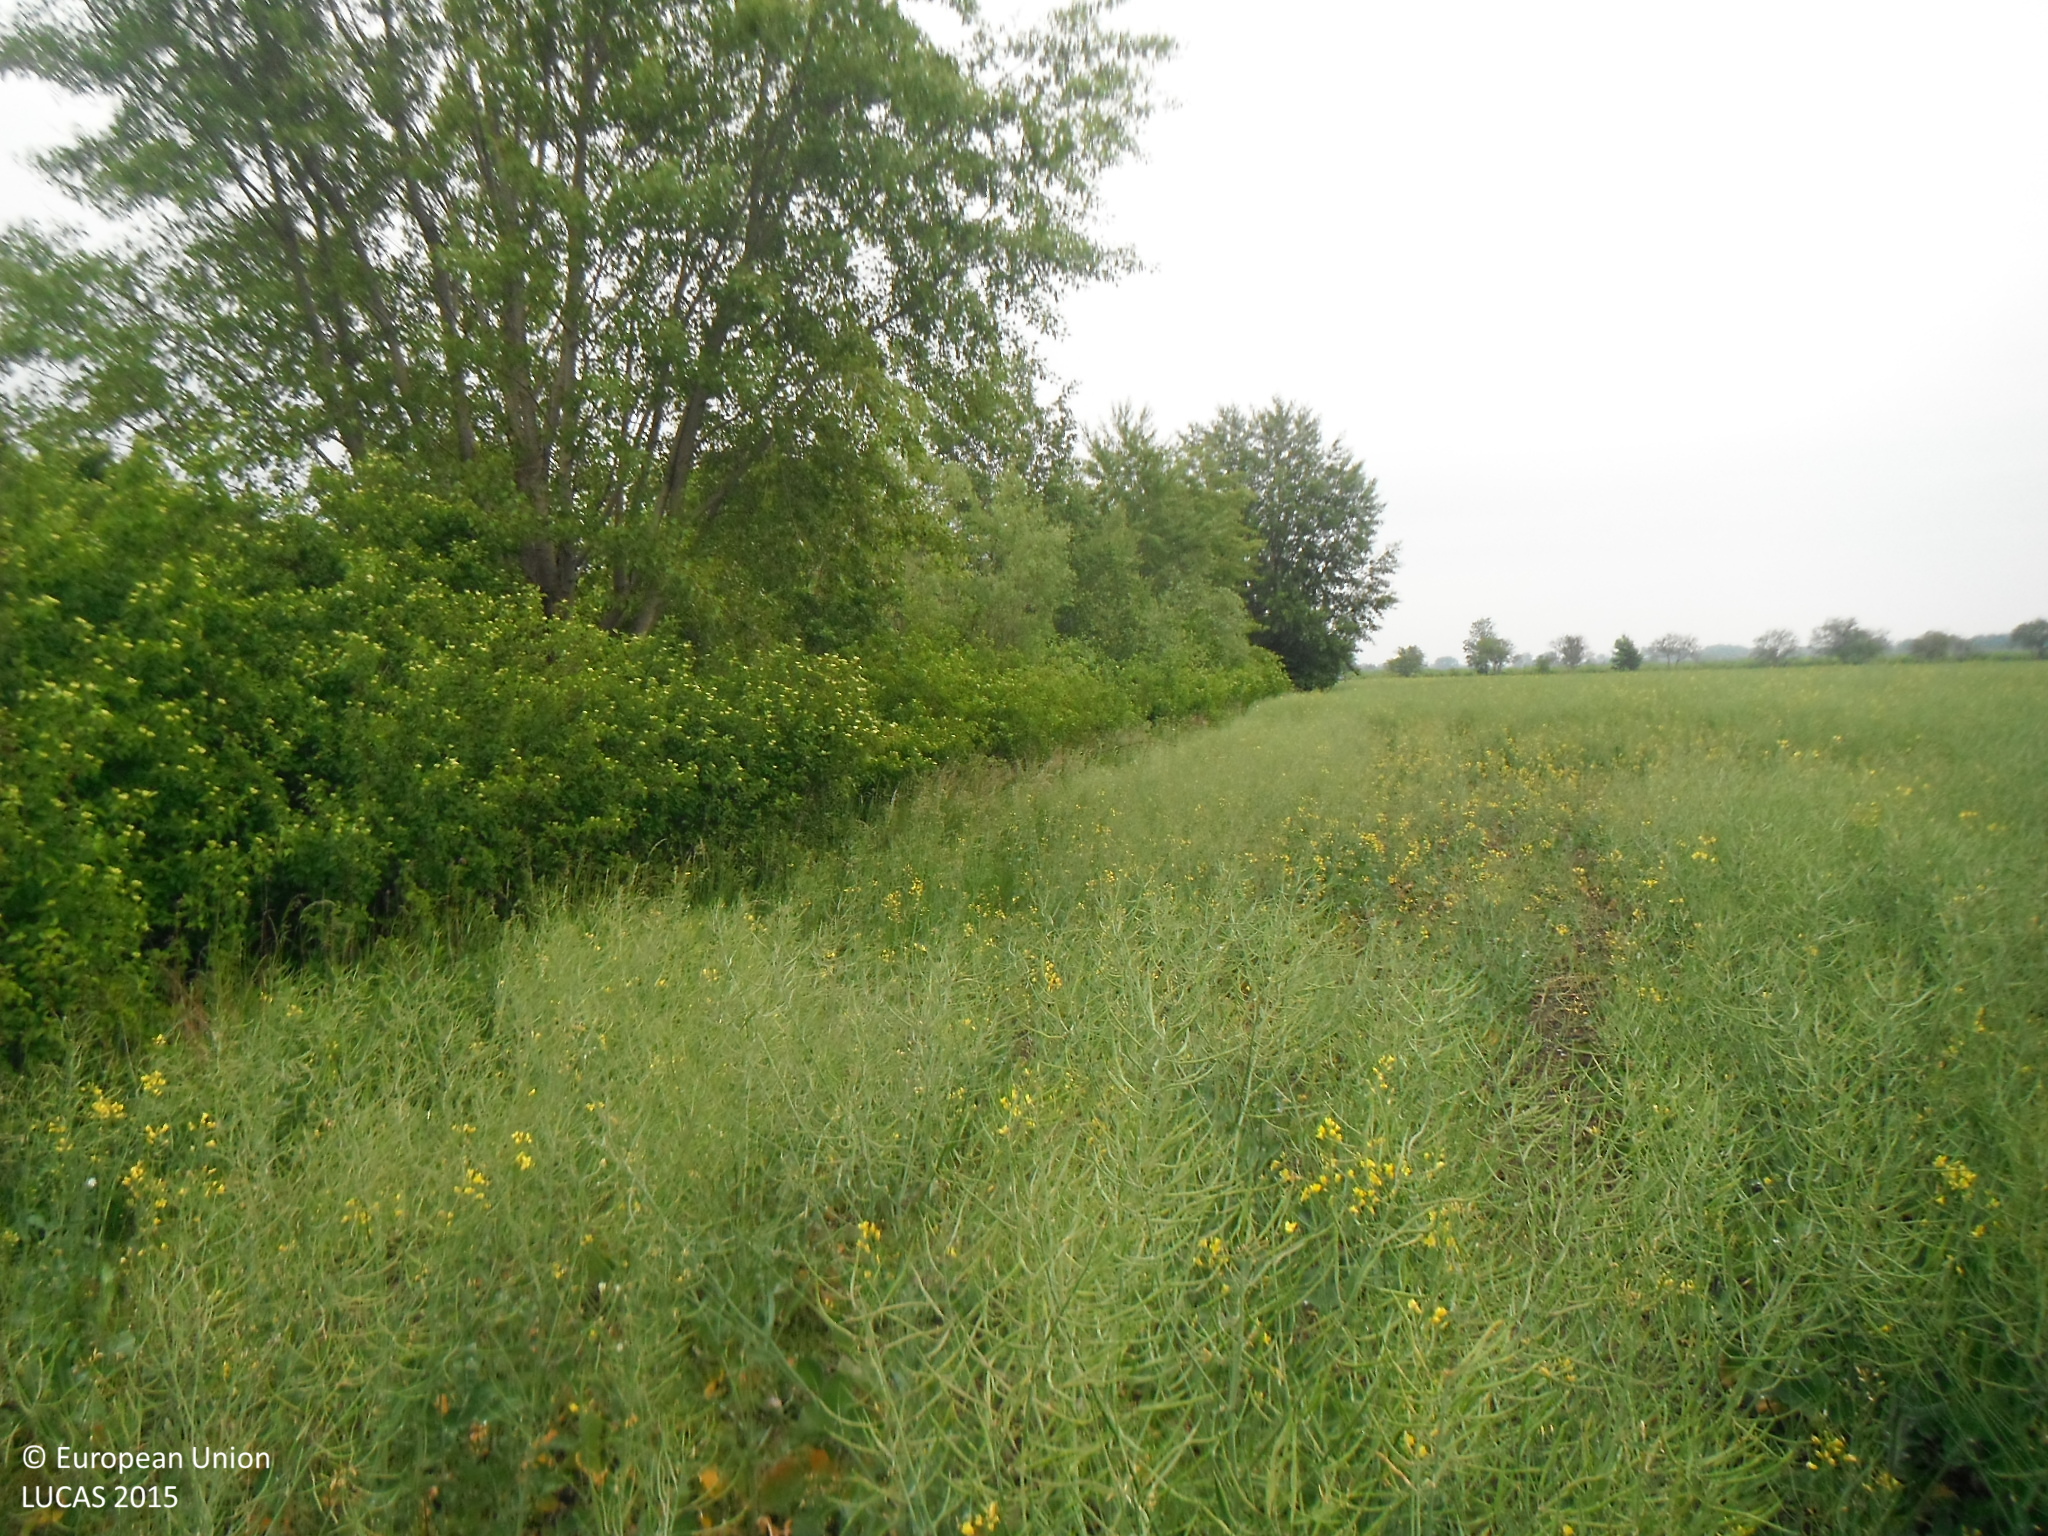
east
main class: Cropland
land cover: Rape and turnip rape
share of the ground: > 75 %
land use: Agriculture (excluding fallow land and kitchen gardens)
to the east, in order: Rape and turnip rape
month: May
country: SK
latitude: 47.9250
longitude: 17.5981
